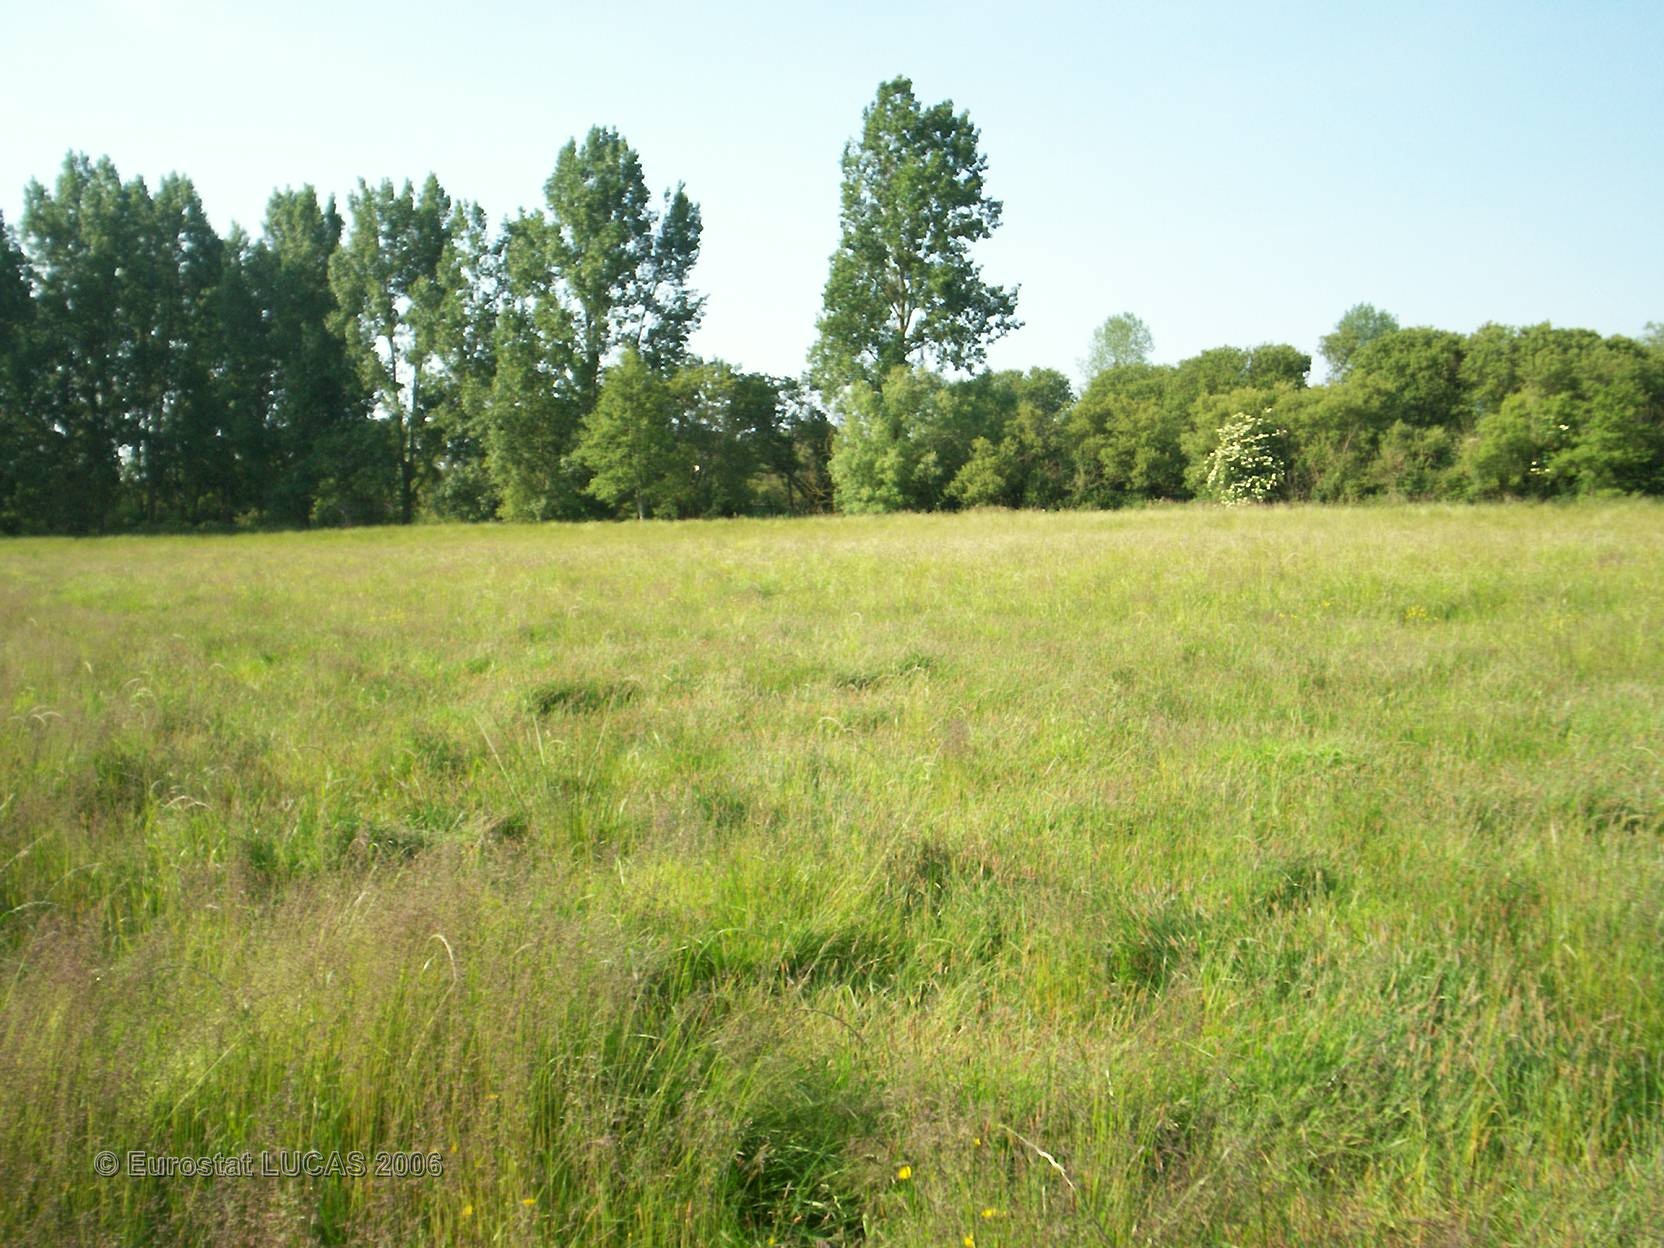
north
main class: Grassland
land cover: Grassland without tree/shrub cover
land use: Agriculture (excluding fallow land and kitchen gardens)
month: June
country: FR
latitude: 48.5421
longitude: -1.7123
